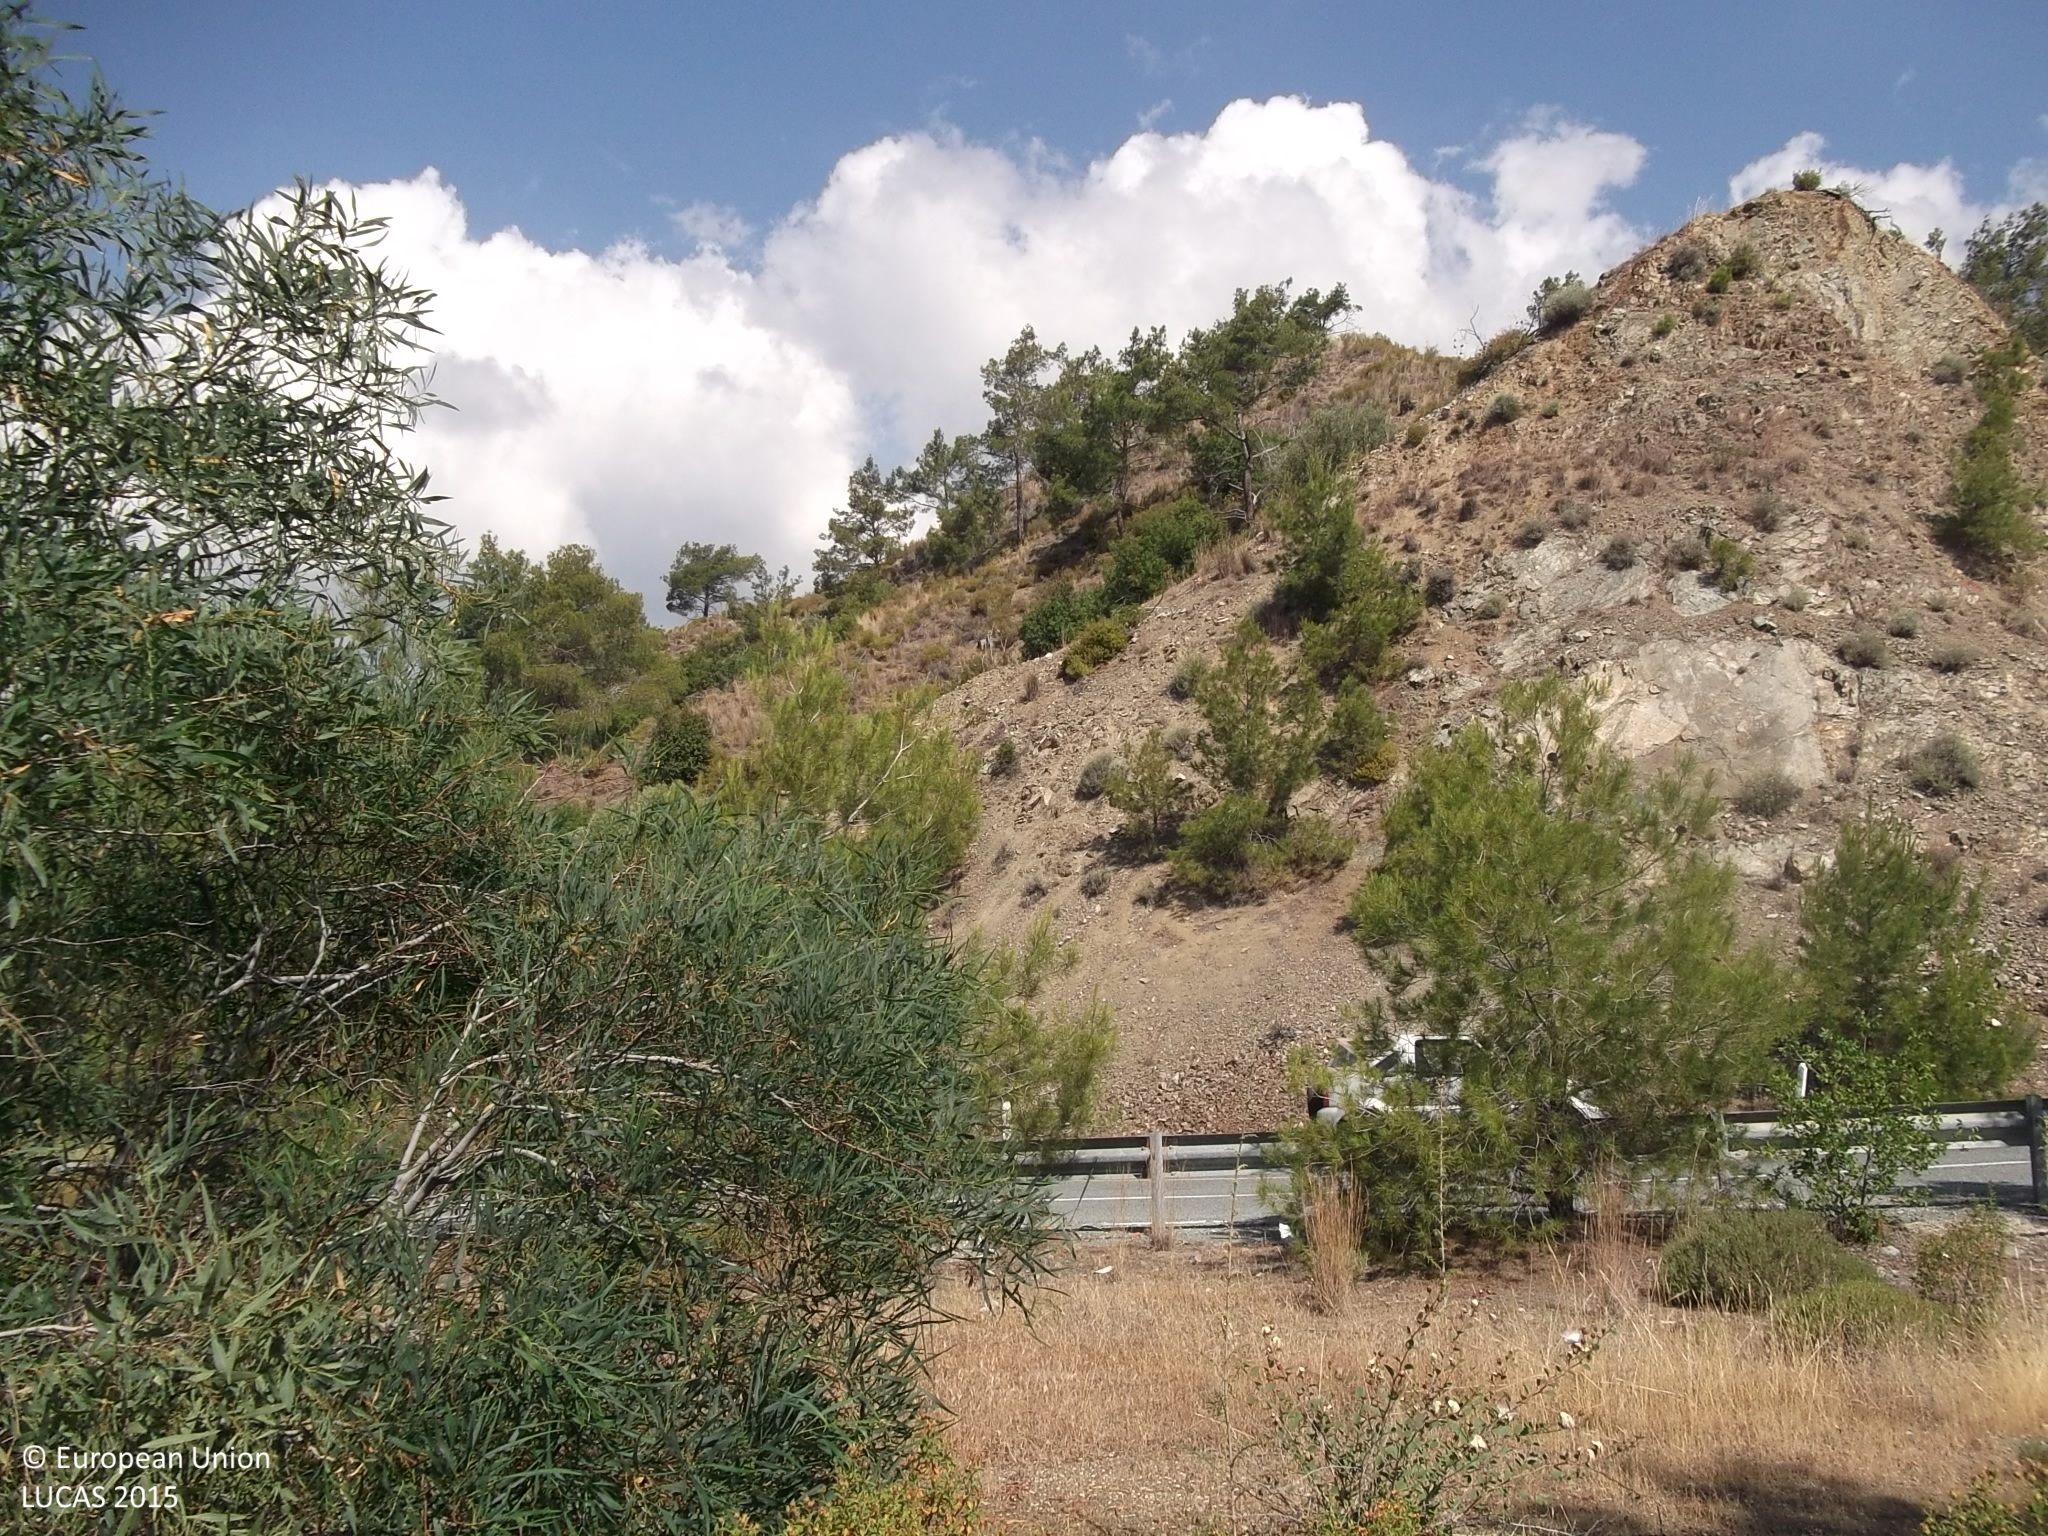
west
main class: Shrubland
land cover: Shrubland with sparse tree cover
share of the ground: > 75 %
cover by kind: shrubs 95 %, broadleaved forest trees 5 %
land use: Semi-natural and natural areas not in use
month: June
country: CY
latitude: 34.8678
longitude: 32.9312
